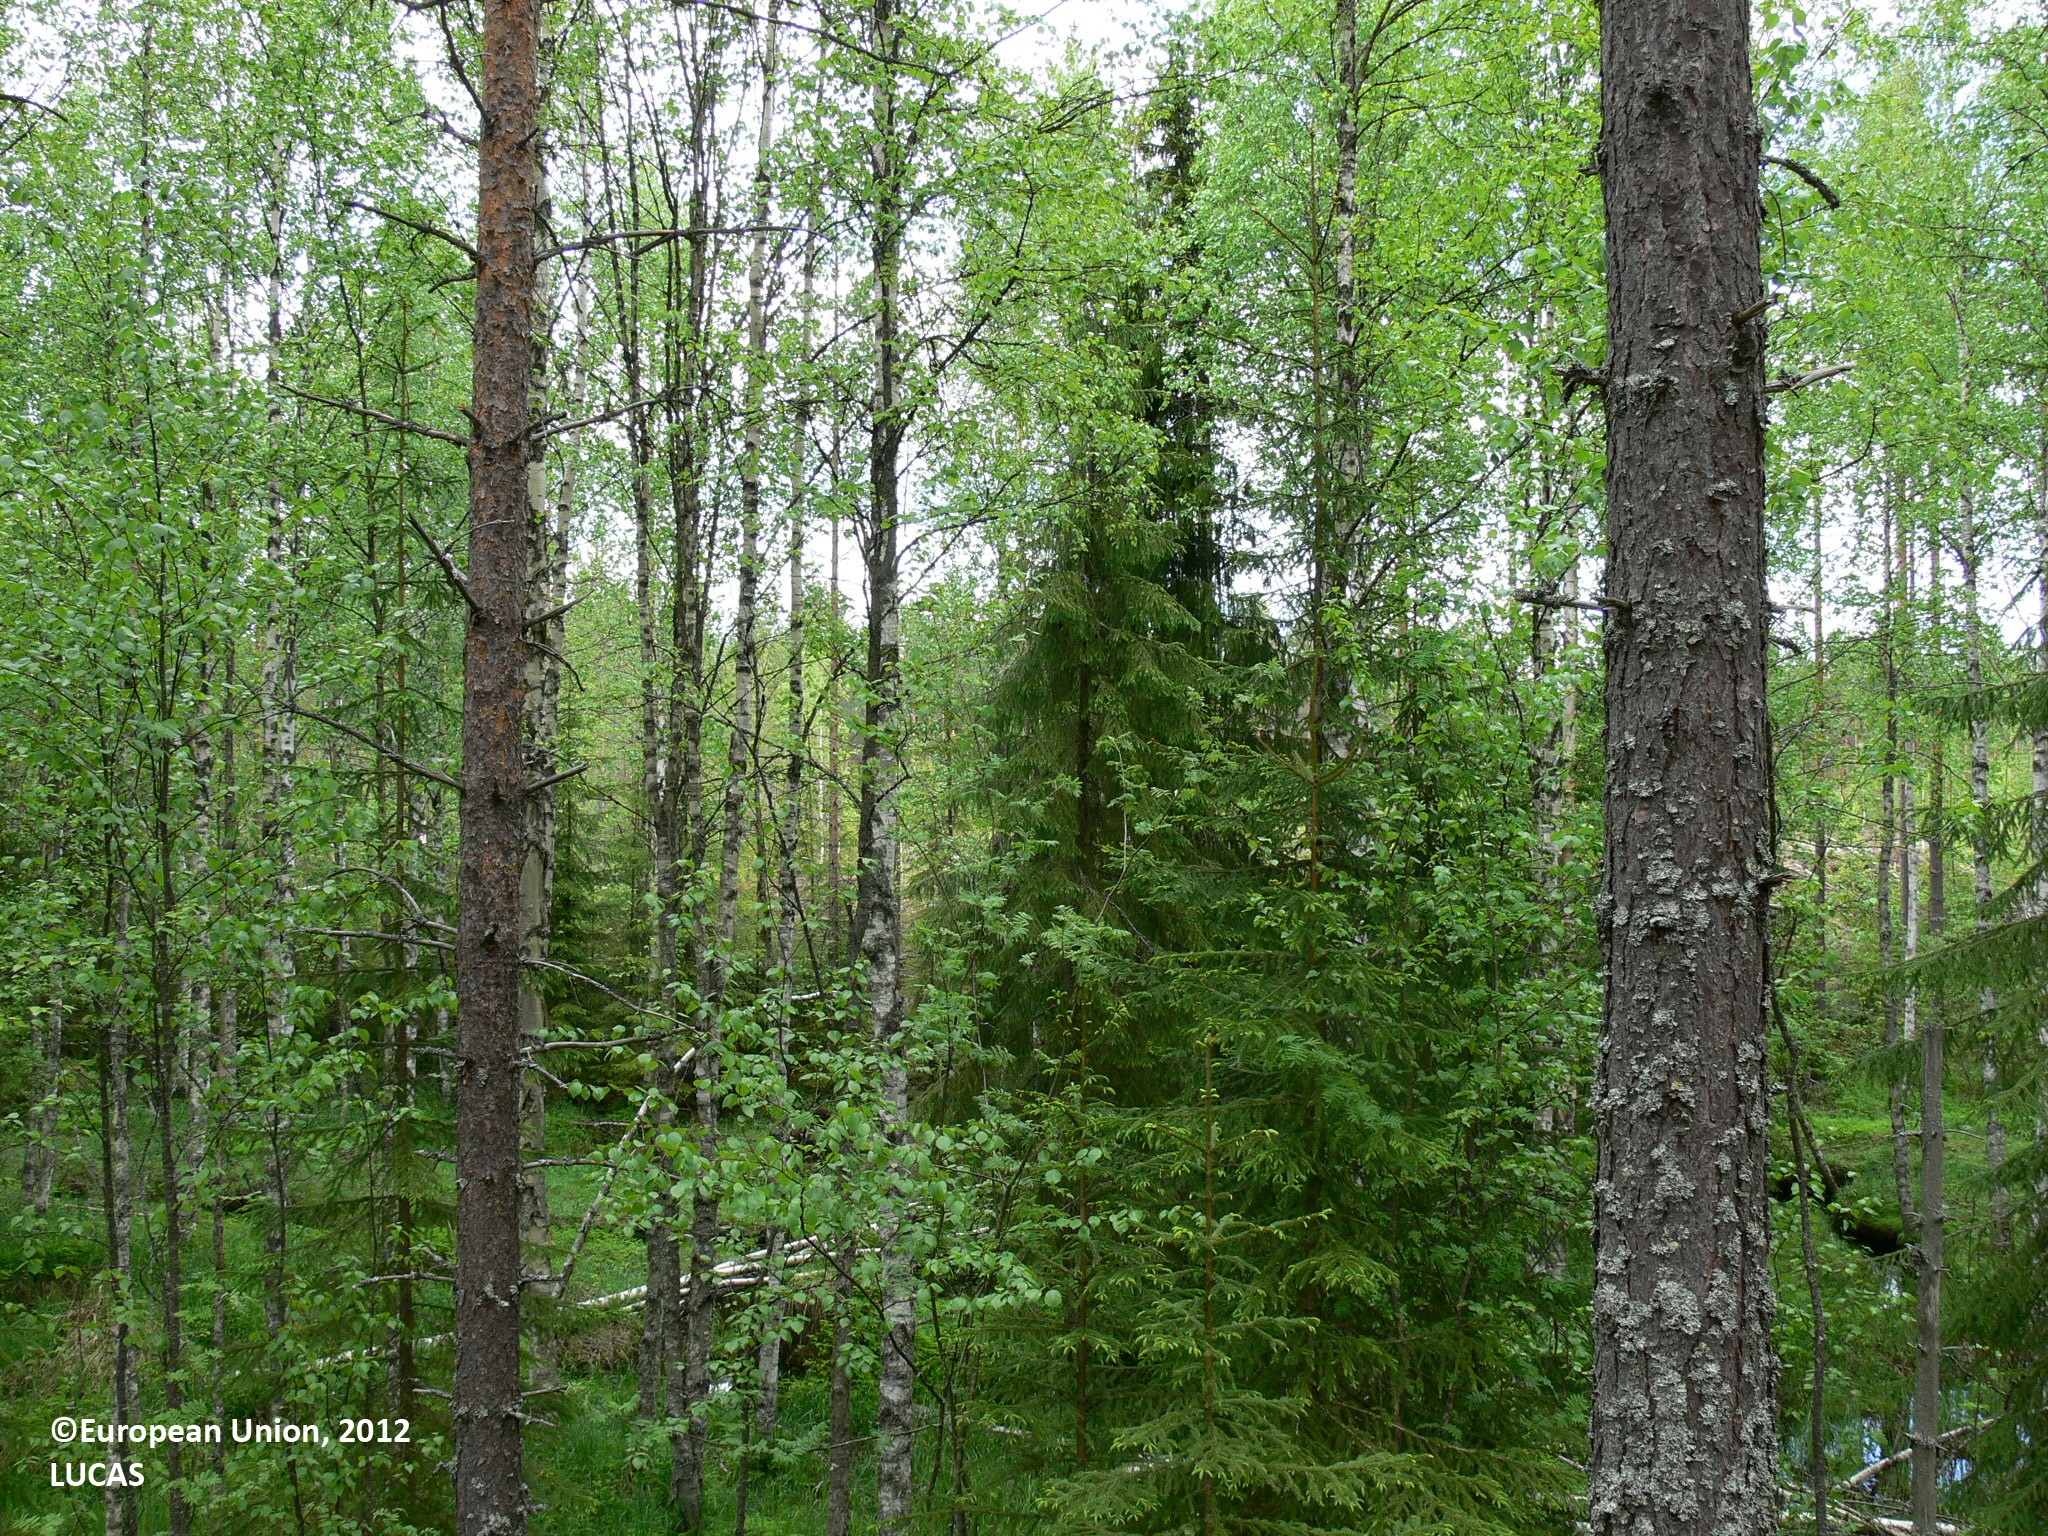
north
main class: Woodland
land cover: Pine dominated coniferous woodland
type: boreal forest
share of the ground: > 75 %
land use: Forestry
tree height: > 5 m
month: June
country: FI
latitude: 62.2679
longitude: 30.3305
